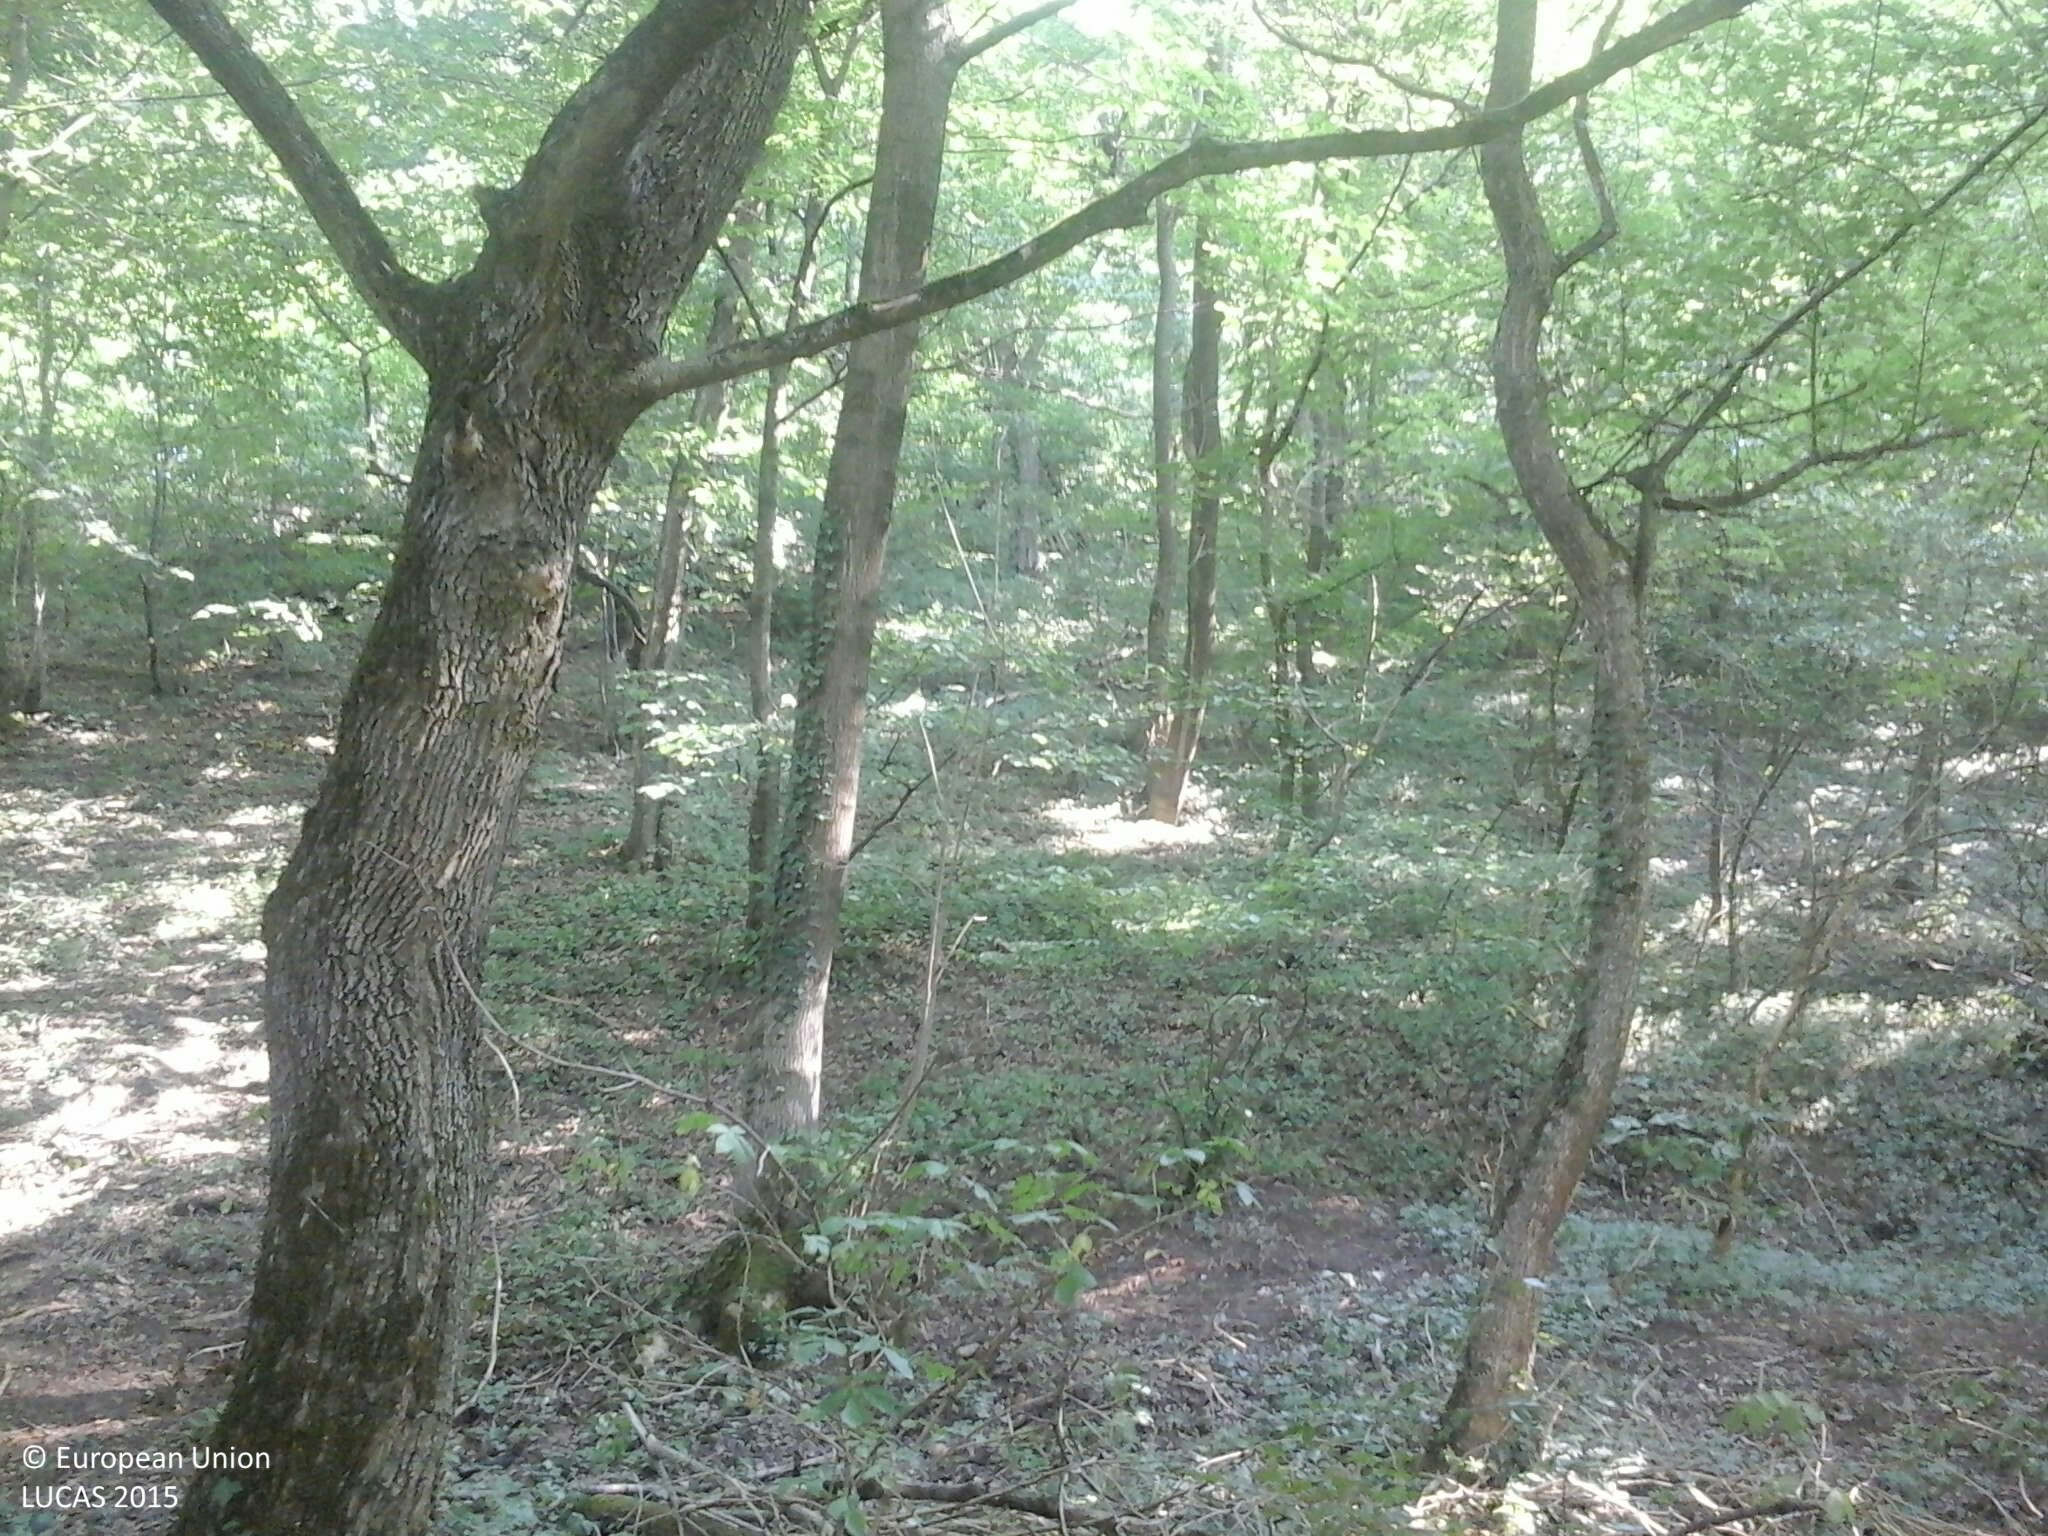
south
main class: Woodland
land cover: Broadleaved woodland
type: mesophytic deciduous forest
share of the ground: > 75 %
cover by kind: broadleaved forest trees 100 %
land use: Forestry
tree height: > 5 m
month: August
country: HU
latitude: 47.7072
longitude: 18.5848
